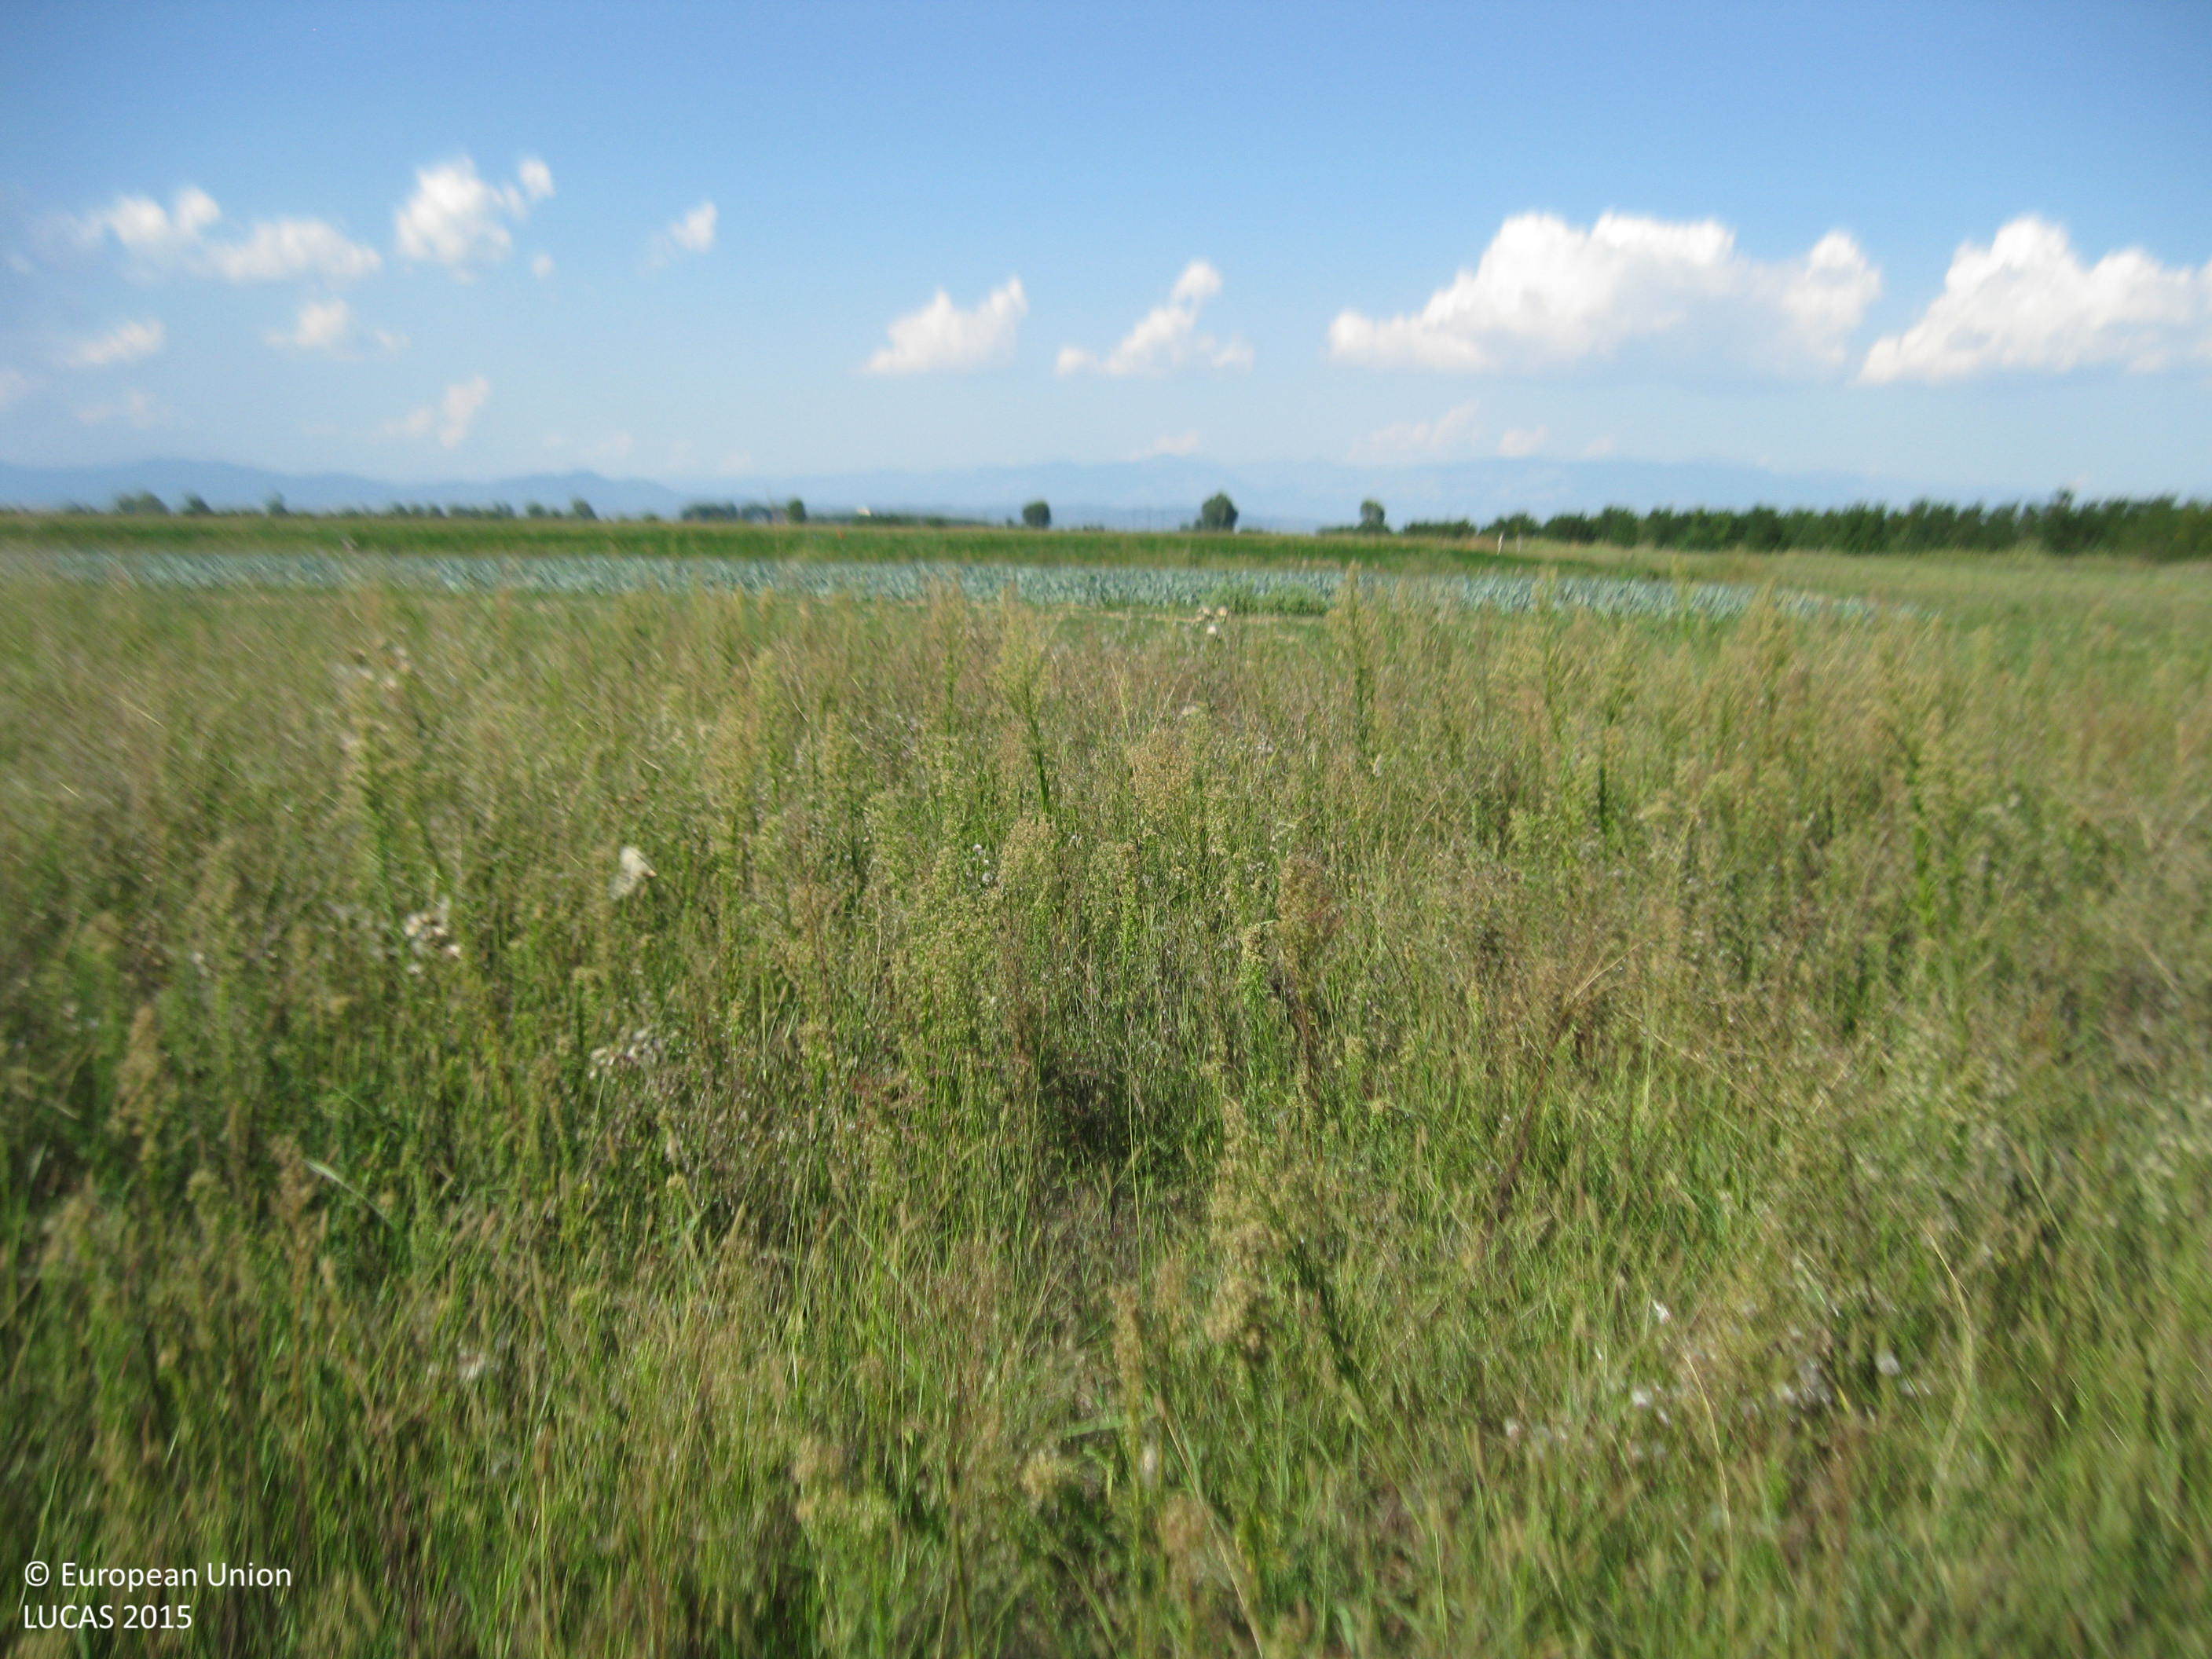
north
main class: Grassland
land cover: Spontaneously vegetated surfaces
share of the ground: > 75 %
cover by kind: herbaceous plants 100 %
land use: Fallow land
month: September
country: BG
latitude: 42.2944
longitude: 24.7905
